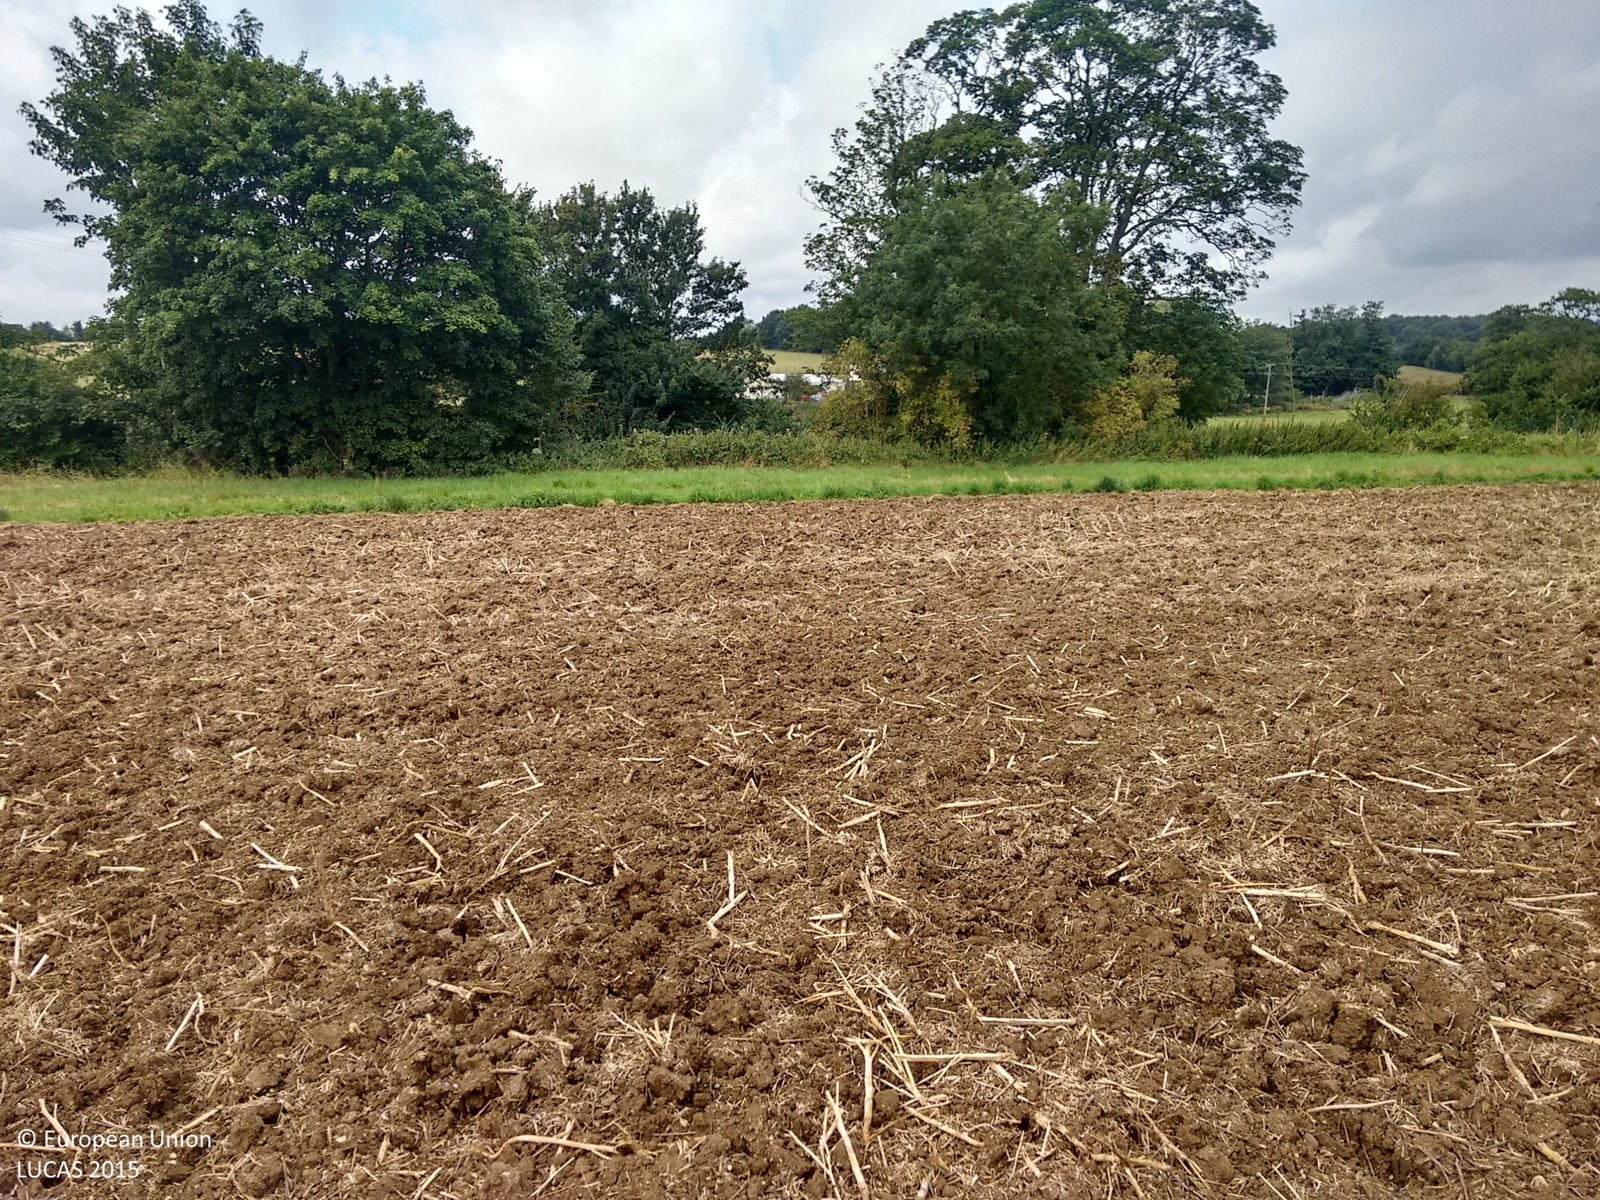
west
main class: Cropland
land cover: Rape and turnip rape
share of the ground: < 10 %
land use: Agriculture (excluding fallow land and kitchen gardens)
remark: Harvested field
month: August
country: GB
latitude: 52.1005
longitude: 0.9103
